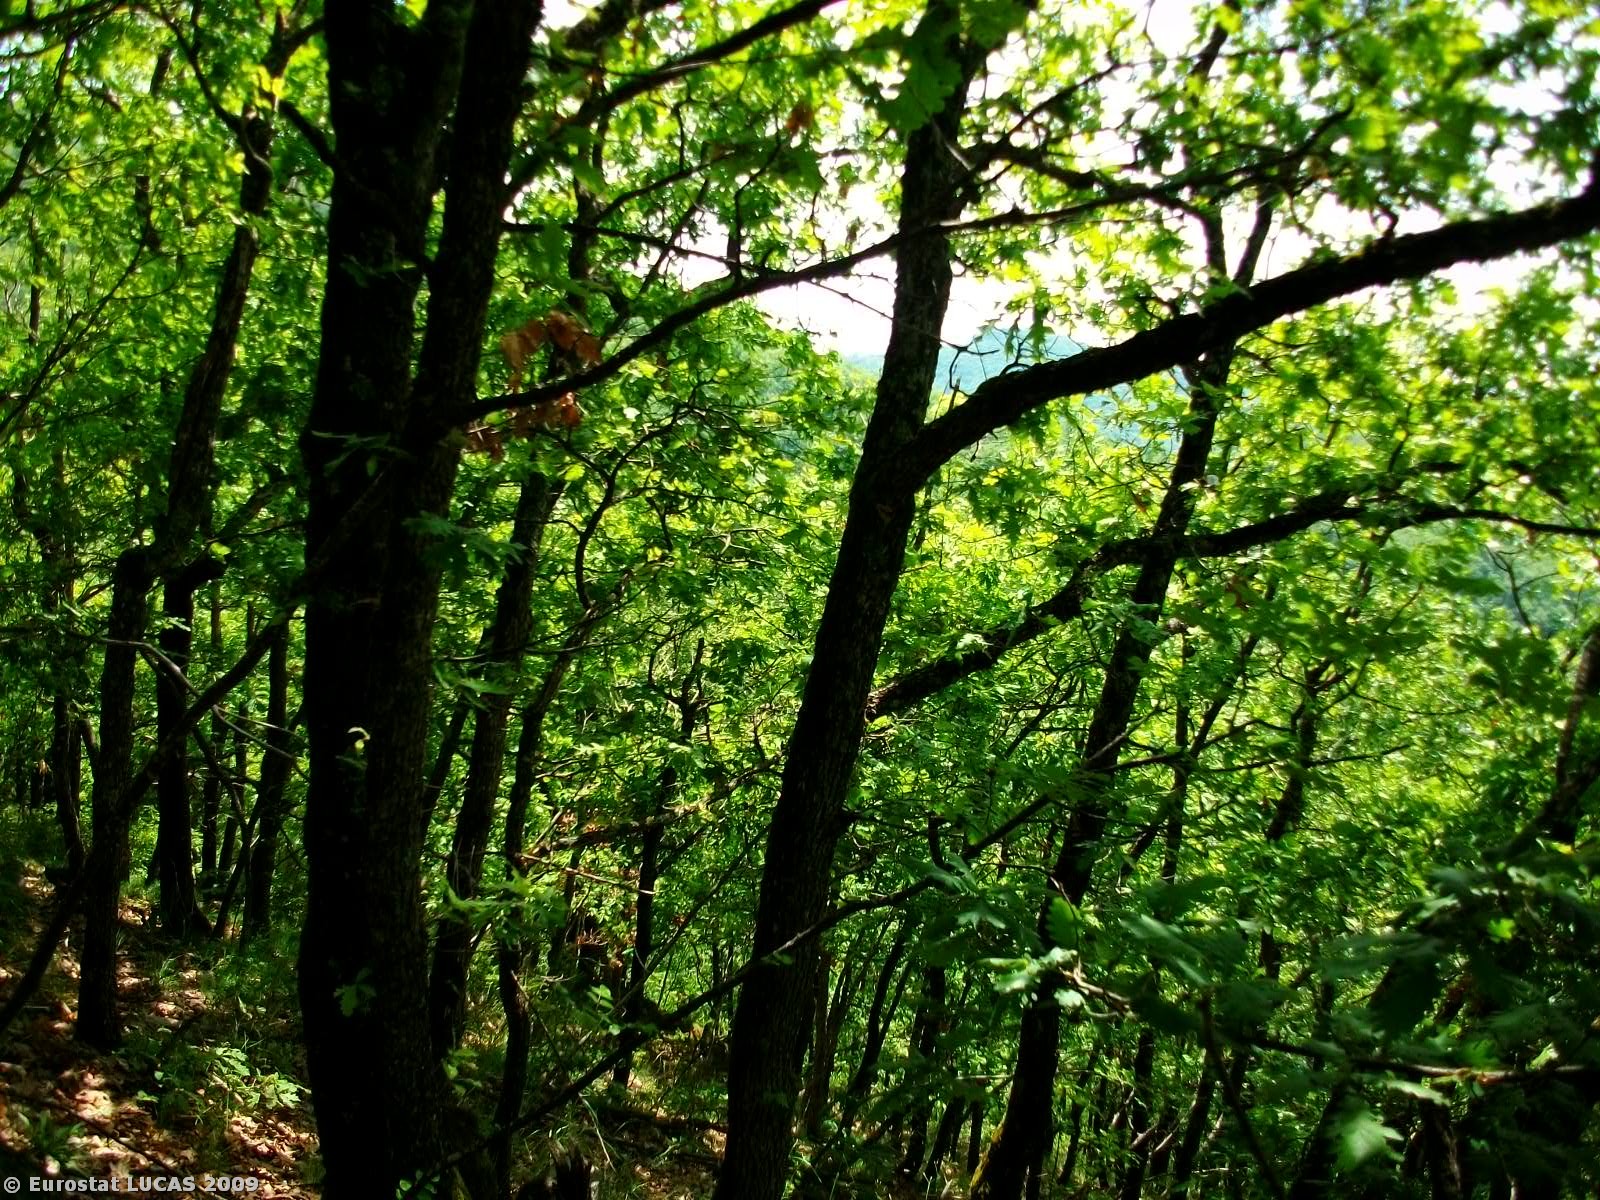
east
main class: Woodland
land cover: Broadleaved woodland
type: mesophytic deciduous forest
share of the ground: > 75 %
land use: Forestry
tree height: > 5 m
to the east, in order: Broadleaved woodland; Rivers and streams; Broadleaved woodland
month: May
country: GR
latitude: 41.2723
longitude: 24.6388
